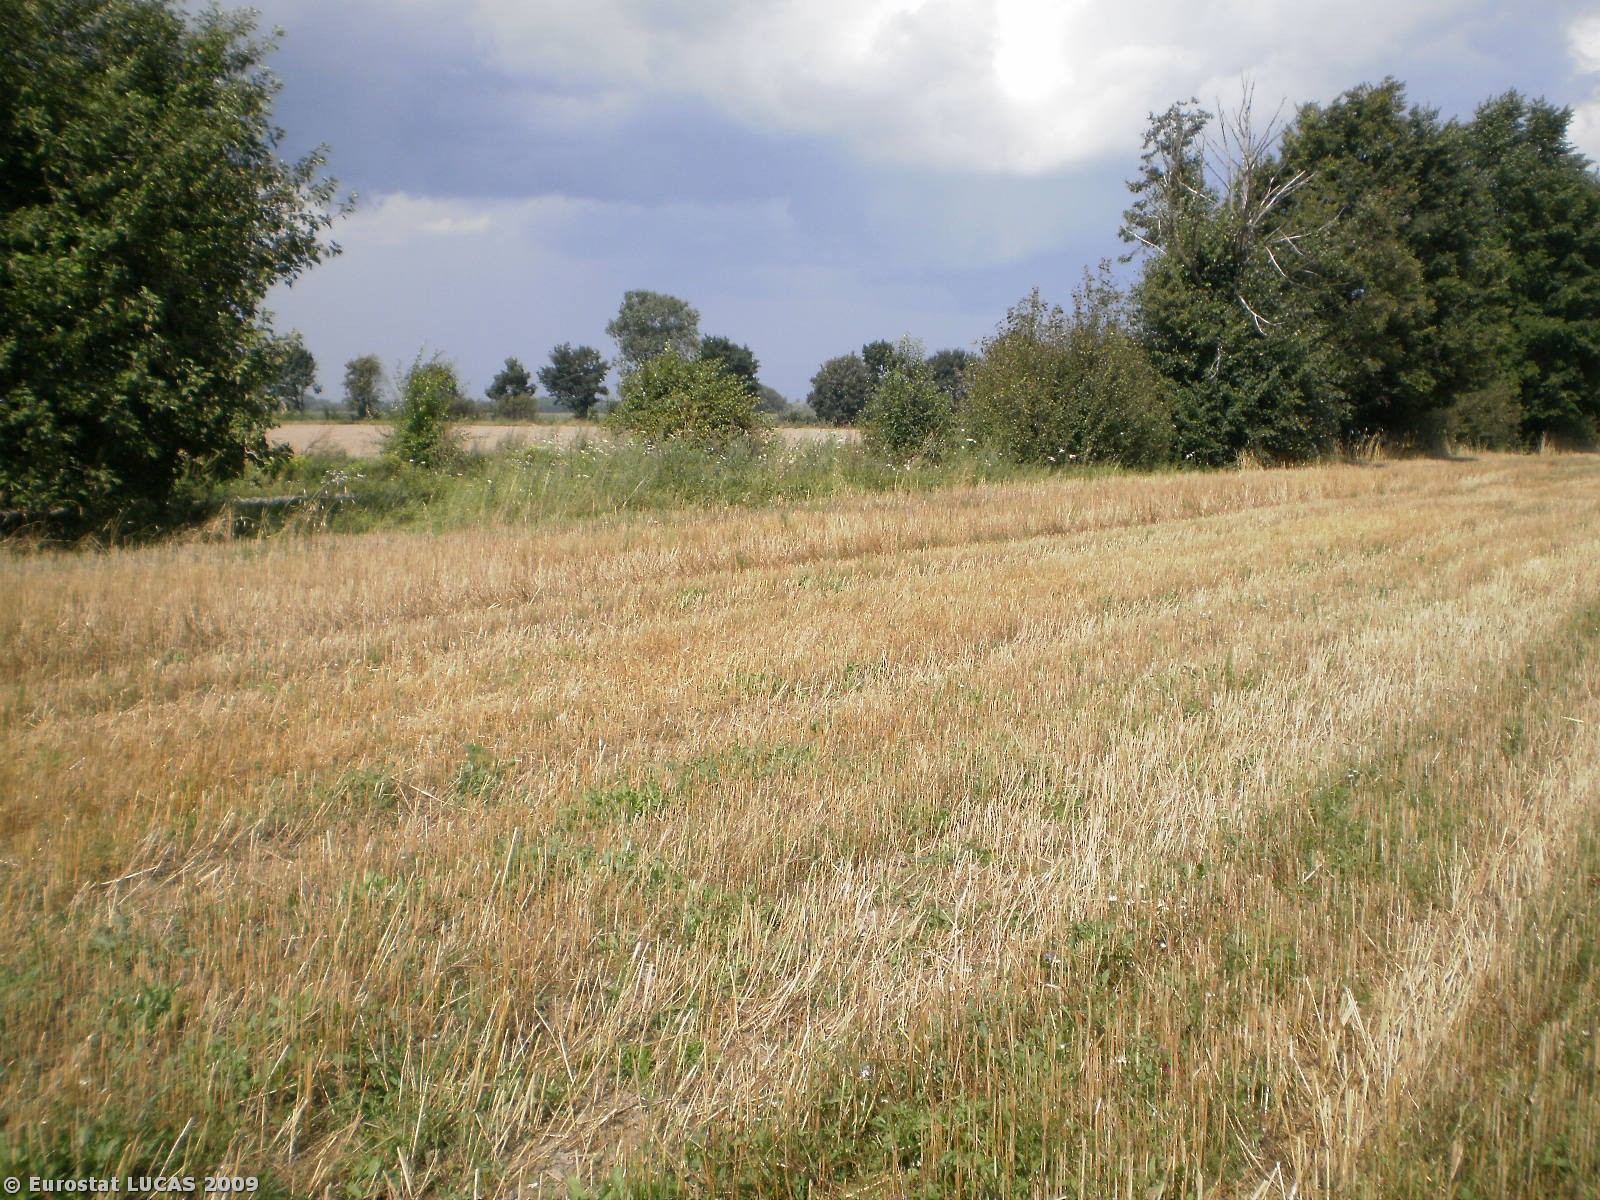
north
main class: Cropland
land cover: Triticale
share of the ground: < 10 %
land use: Agriculture (excluding fallow land and kitchen gardens)
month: August
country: PL
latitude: 52.9713
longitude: 21.1996
